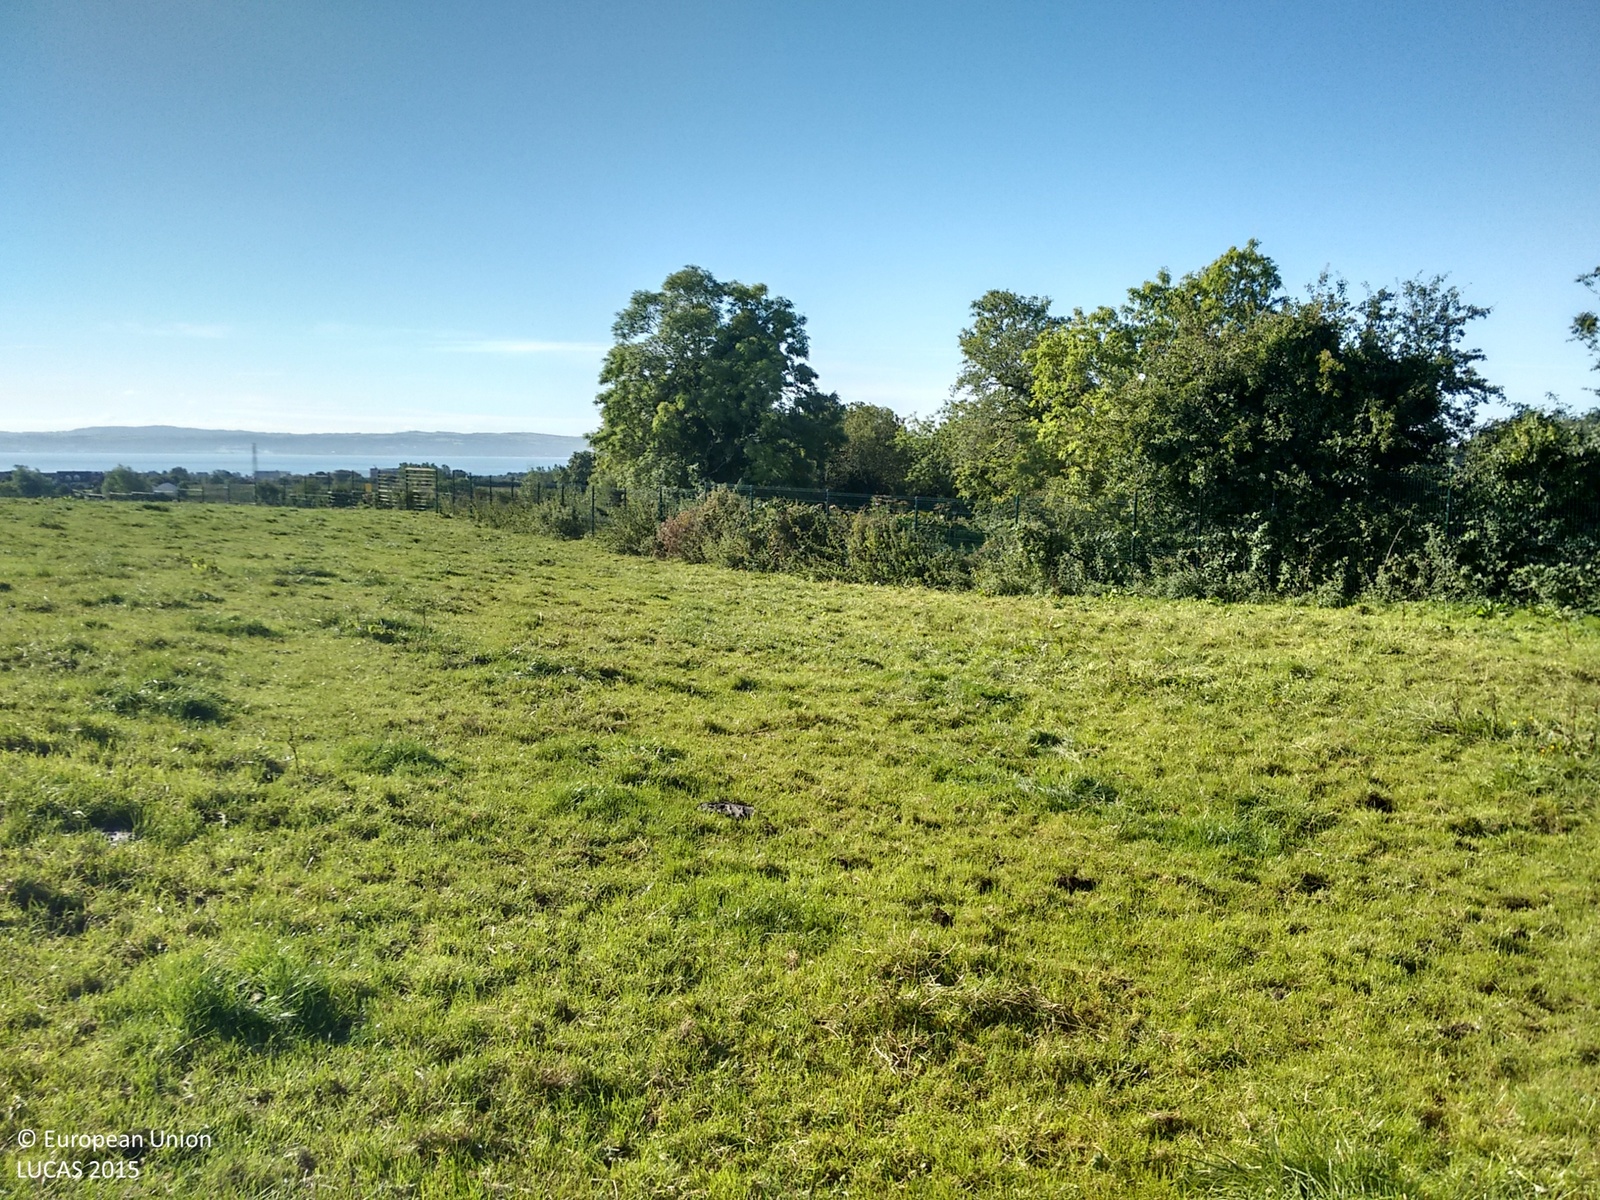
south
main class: Grassland
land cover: Grassland without tree/shrub cover
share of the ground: > 75 %
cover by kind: herbaceous plants 100 %
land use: Agriculture (excluding fallow land and kitchen gardens)
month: September
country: GB
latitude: 54.7357
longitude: -5.8376
